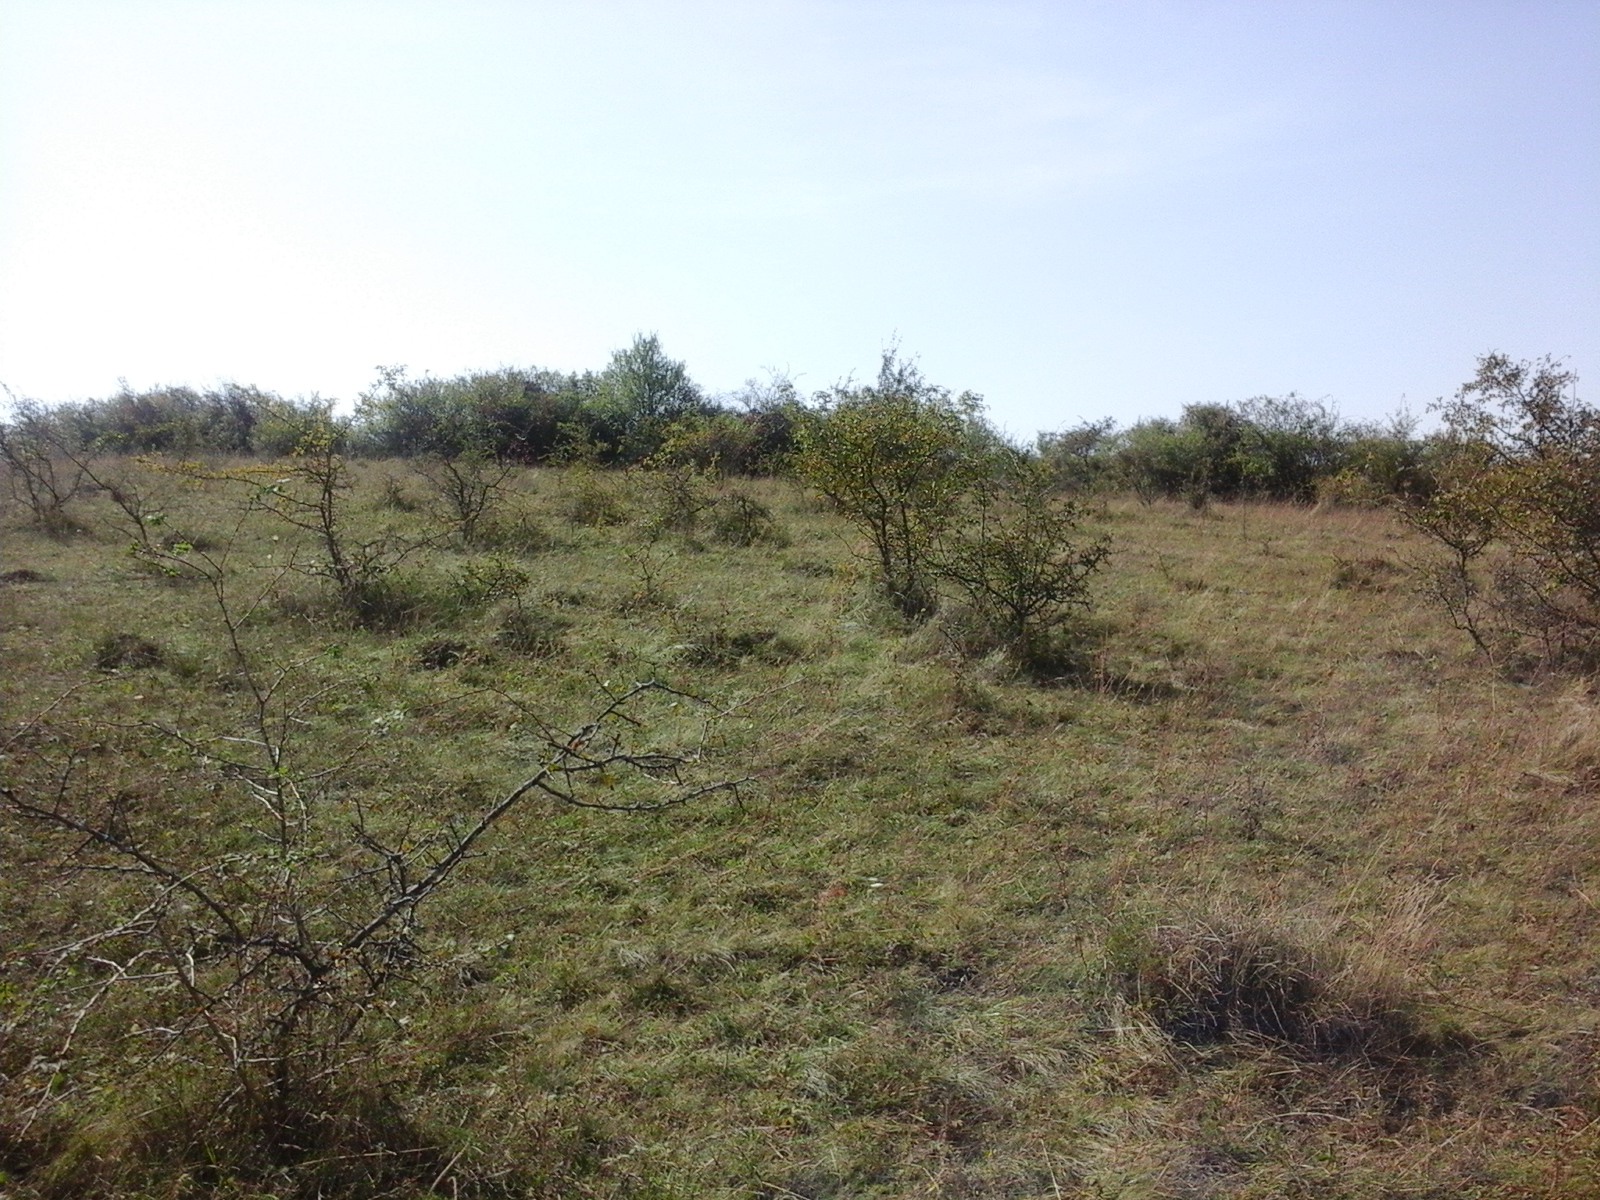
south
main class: Grassland
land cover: Grassland with sparse tree/shrub cover
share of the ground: > 75 %
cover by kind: herbaceous plants 85 %, shrubs 10 %, broadleaved forest trees 5 %
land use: Agriculture (excluding fallow land and kitchen gardens)
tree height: < 5 m
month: September
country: RO
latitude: 46.8994
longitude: 23.8998
